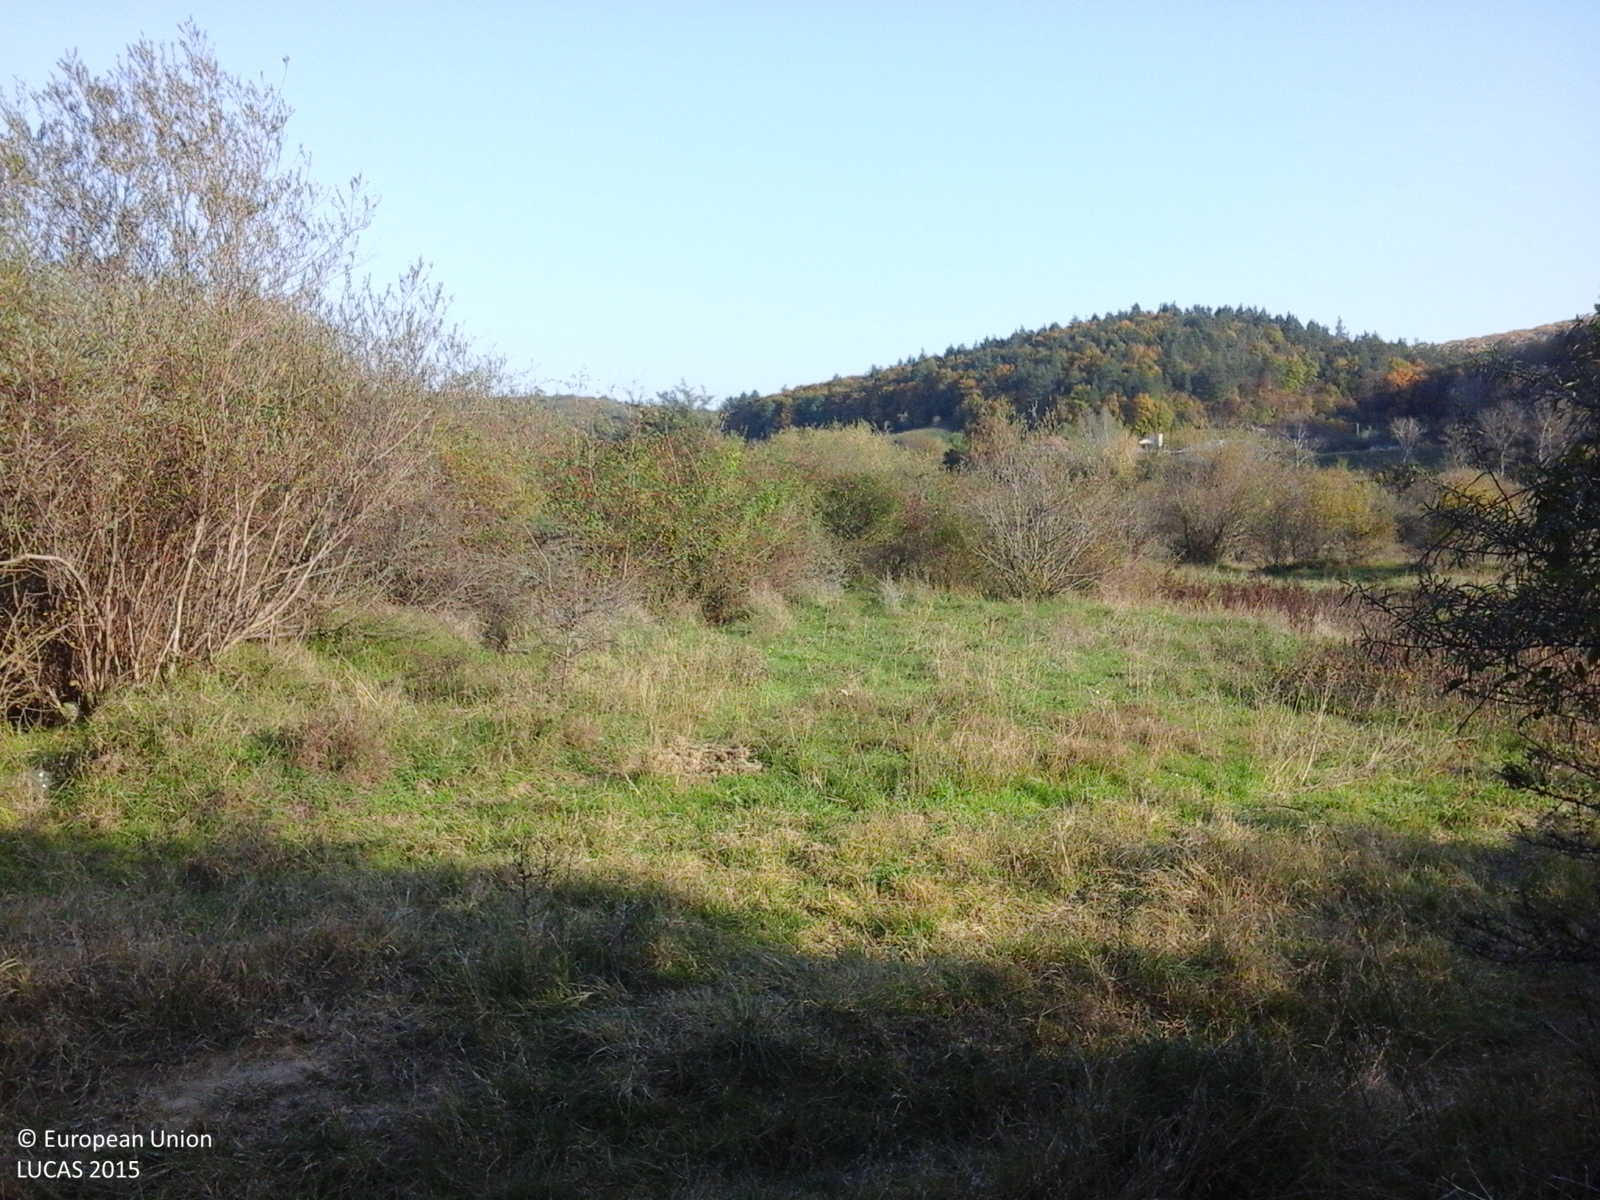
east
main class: Shrubland
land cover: Shrubland without tree cover
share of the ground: > 75 %
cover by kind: shrubs 100 %
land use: Semi-natural and natural areas not in use
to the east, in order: Shrubland without tree cover; Tracks; Grassland with sparse tree/shrub cover; Tracks; Grassland with sparse tree/shrub cover; Shrubland without tree cover
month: October
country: RO
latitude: 45.2153
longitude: 26.6683
